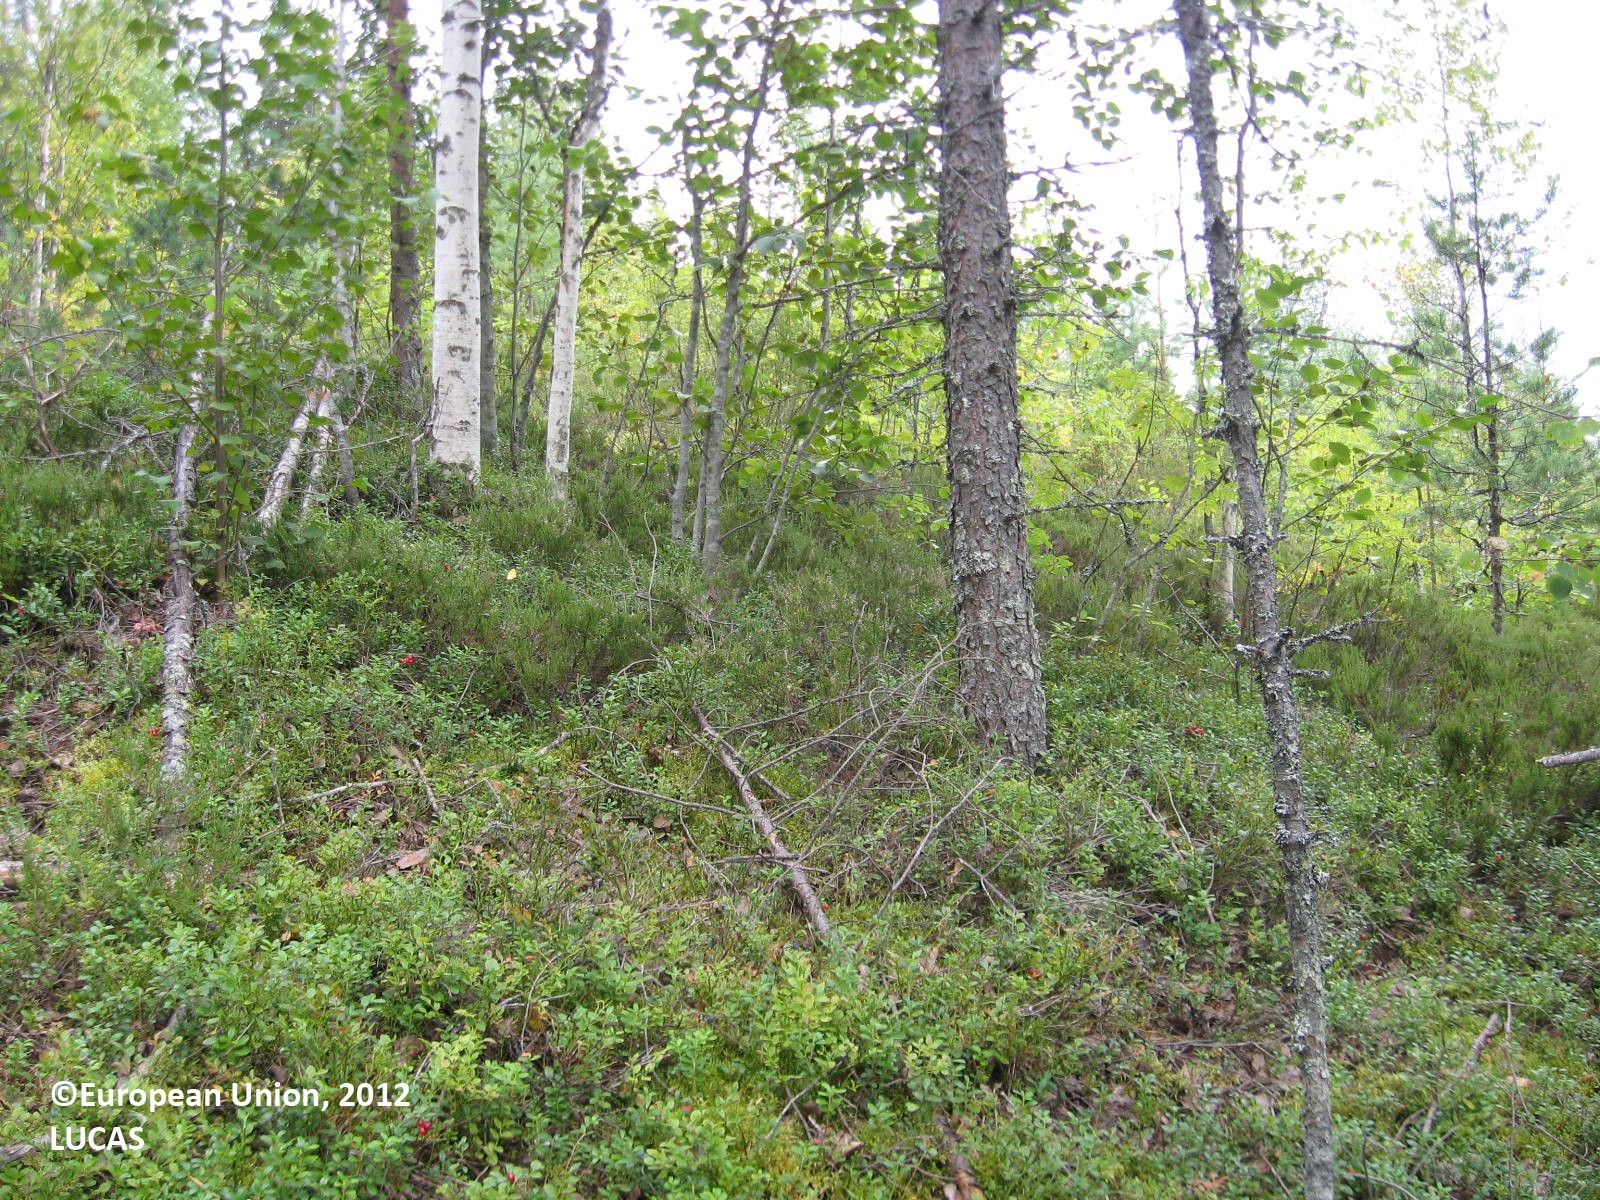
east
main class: Woodland
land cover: Pine dominated mixed woodland
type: boreal forest
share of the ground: 50 - 75 %
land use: Forestry
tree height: > 5 m
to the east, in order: Pine dominated mixed woodland; Spruce dominated coniferous woodland; Grass margins; Abandoned hedges; Grass margins; Tracks; Other mixed woodland; Tracks; Shruby margins; Ditches and canals; Other coniferous woodland; Ditches and canals; Shruby margins; Tracks; Other mixed woodland; Ditches and canals; Other mixed woodland; Ditches and canals; Other mixed woodland
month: August
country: FI
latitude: 63.6827
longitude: 29.2808
